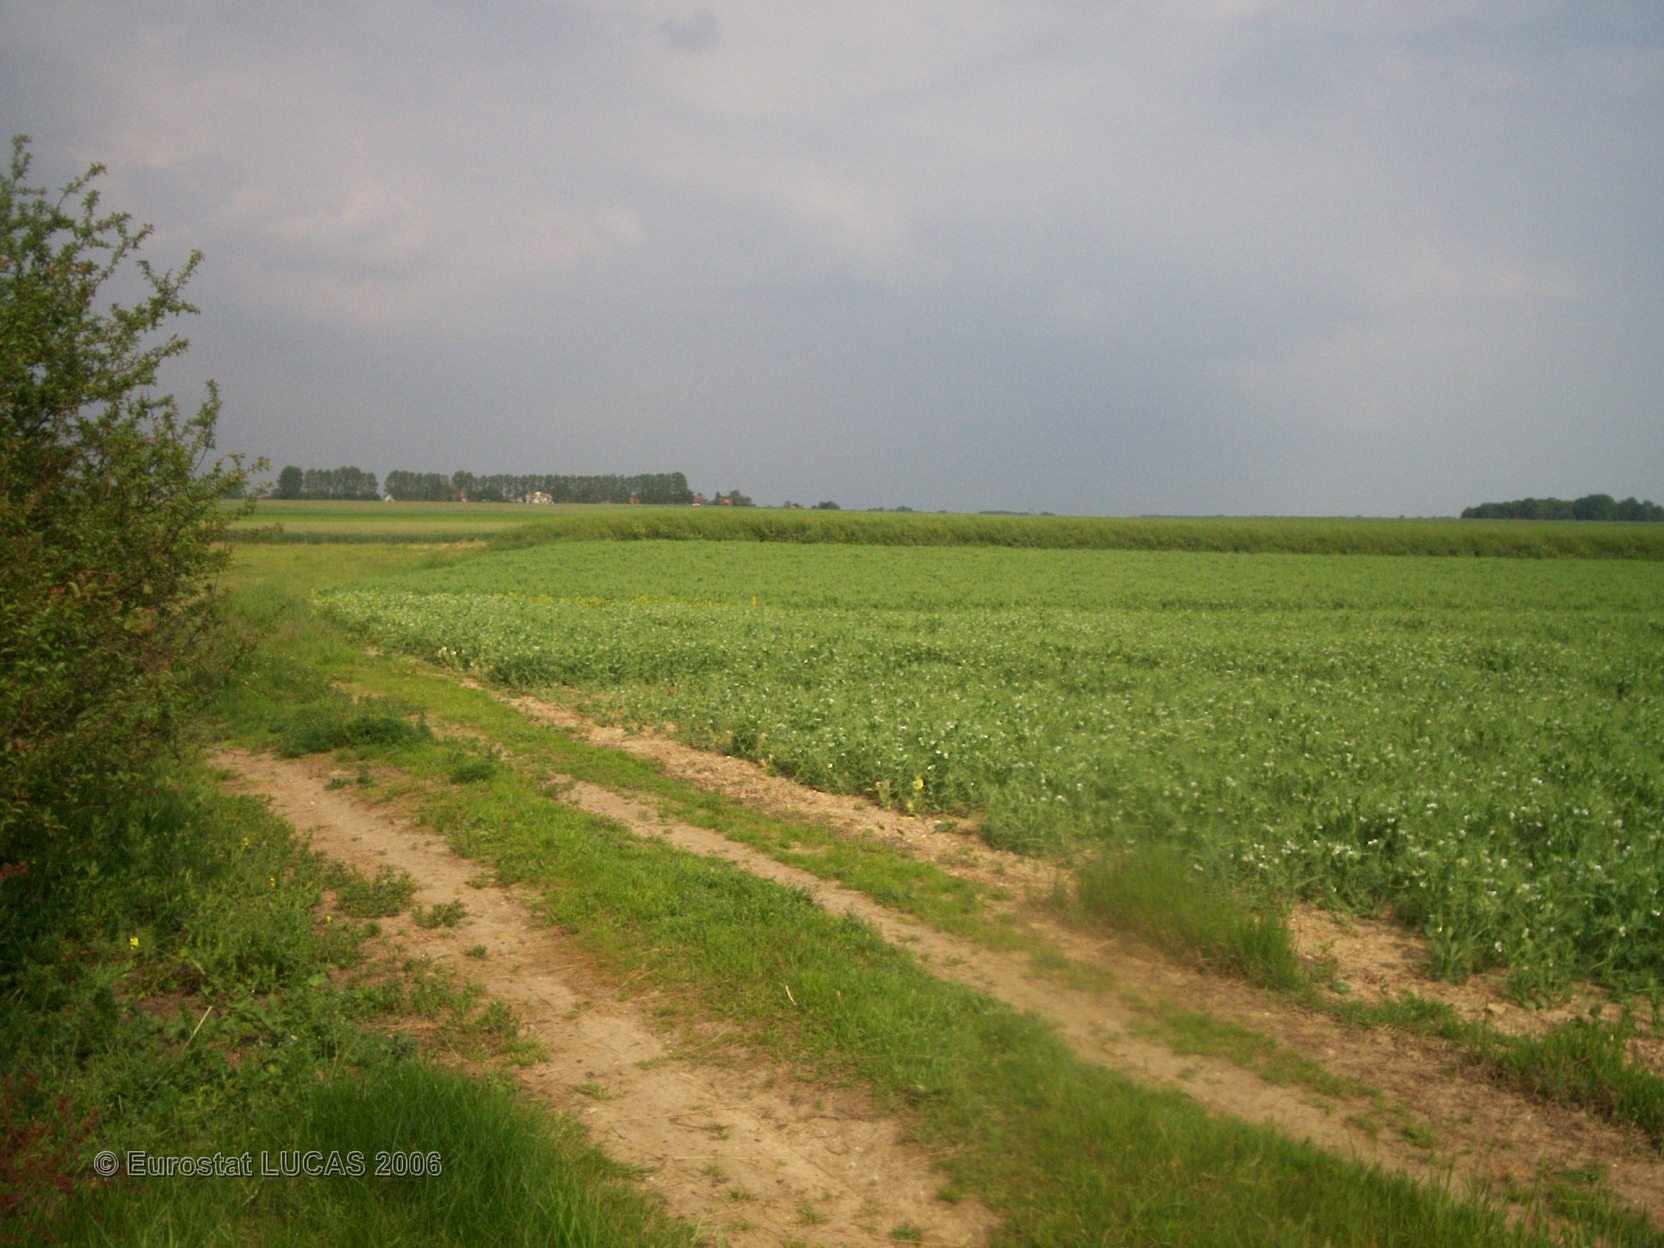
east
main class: Grassland
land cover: Grassland with sparse tree/shrub cover
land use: Railway transport
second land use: Transport via pipelines
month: June
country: FR
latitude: 49.6604
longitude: 2.6881
